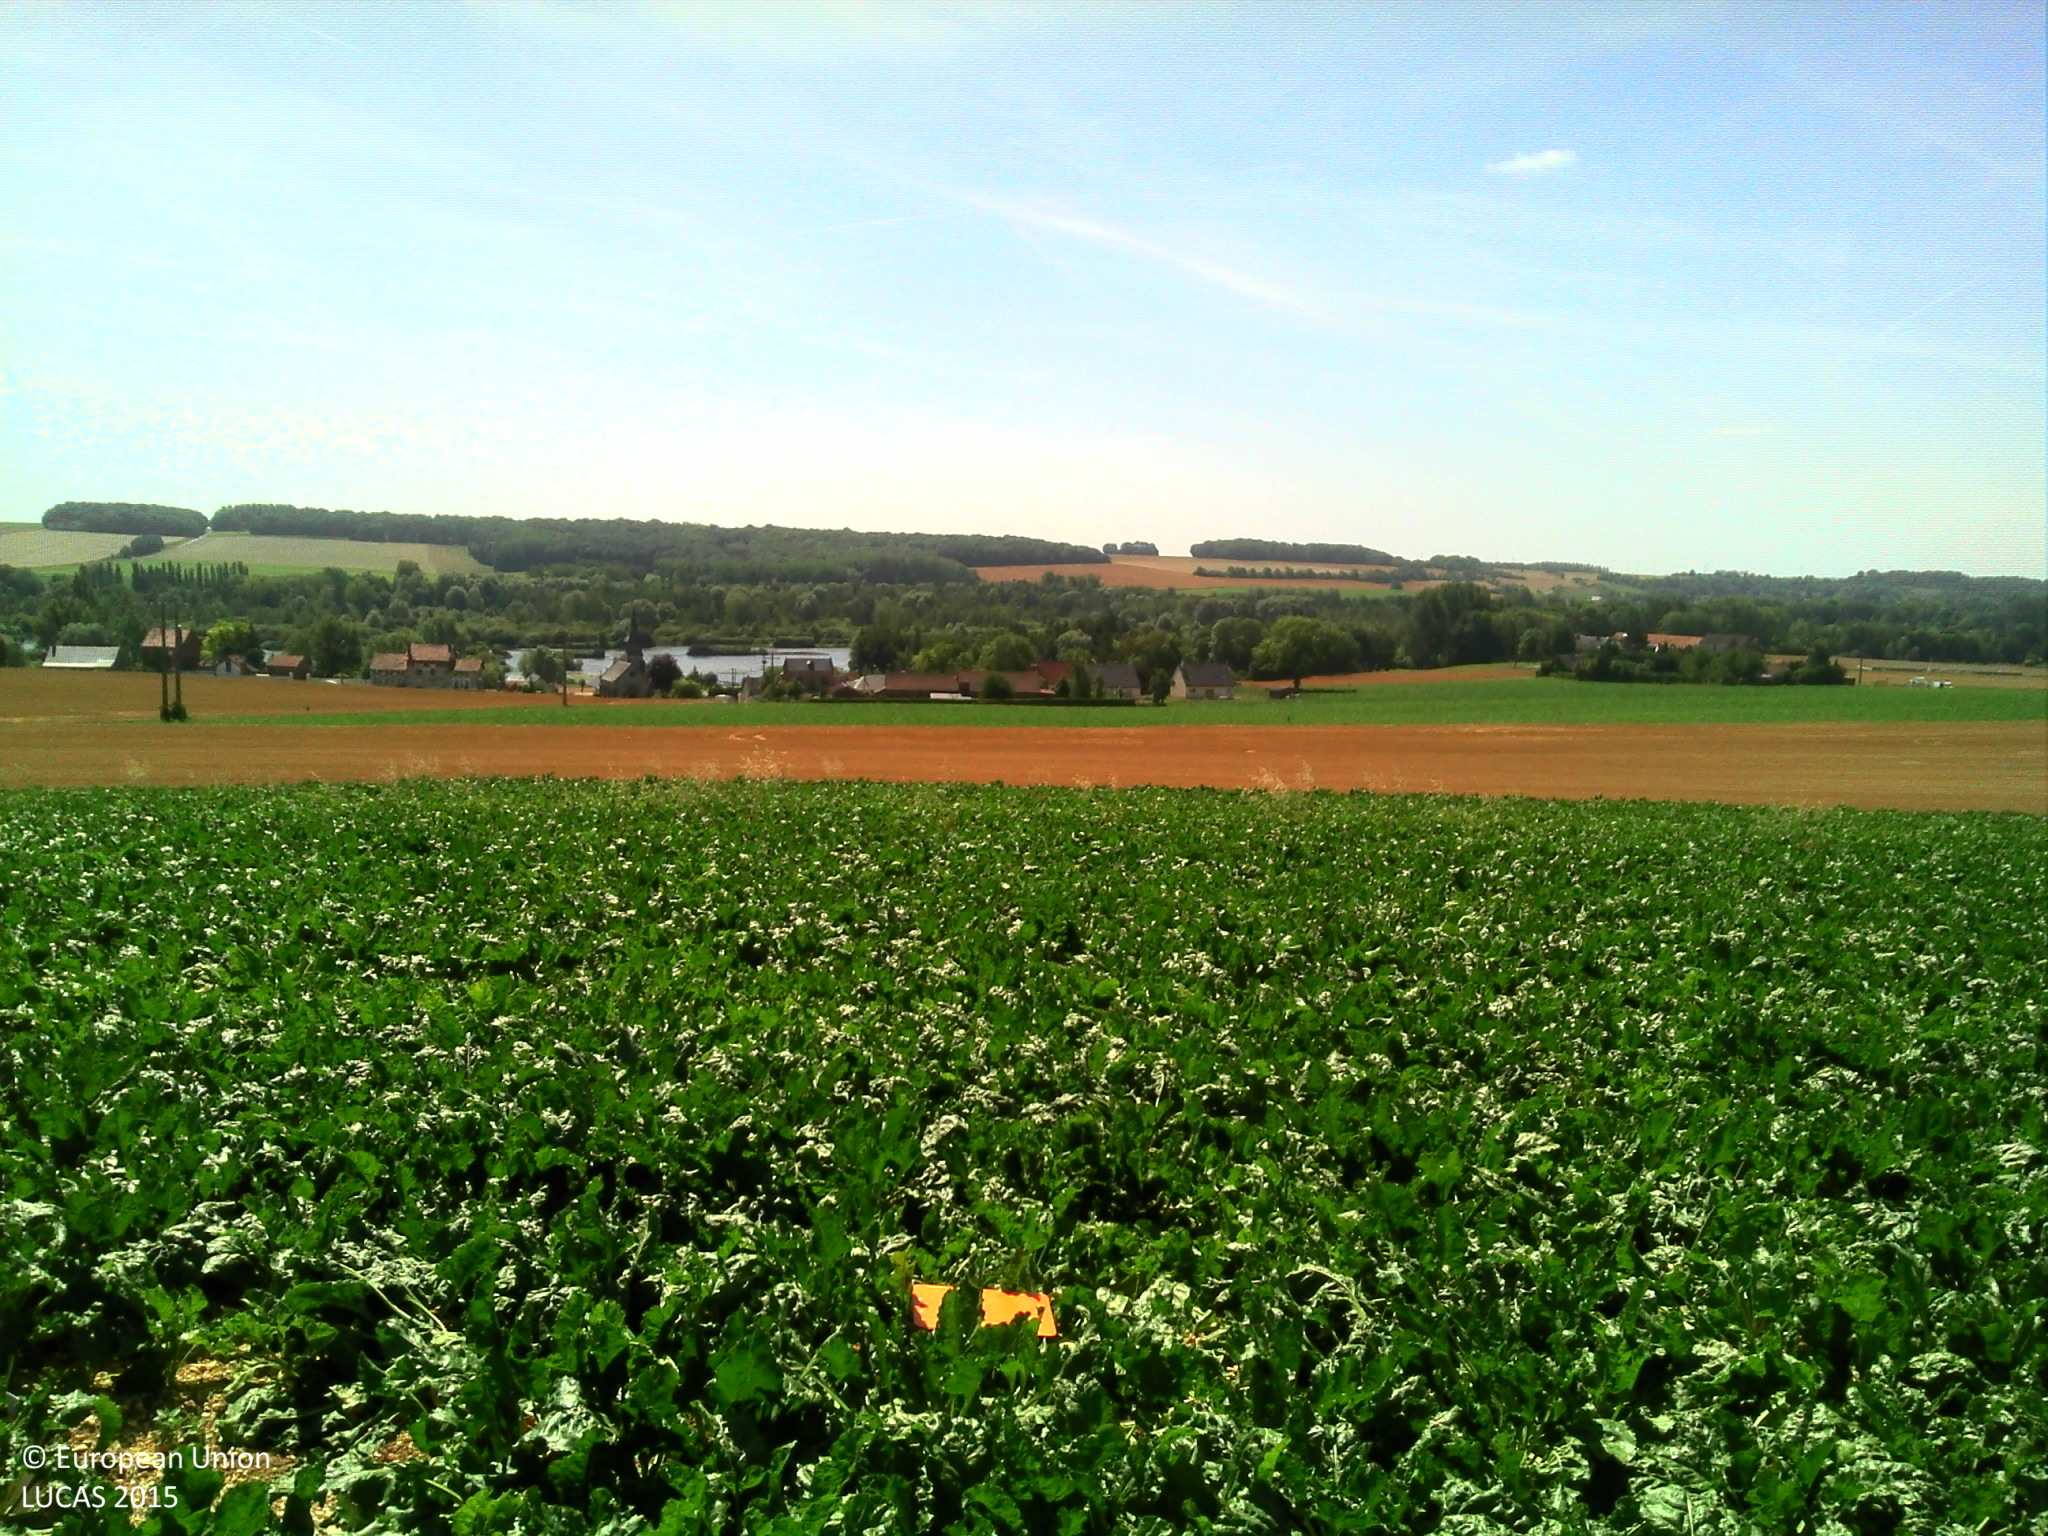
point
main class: Cropland
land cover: Sugar beet
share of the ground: > 75 %
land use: Agriculture (excluding fallow land and kitchen gardens)
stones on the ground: 25 - 50 %
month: August
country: FR
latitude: 49.9590
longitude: 2.8386
